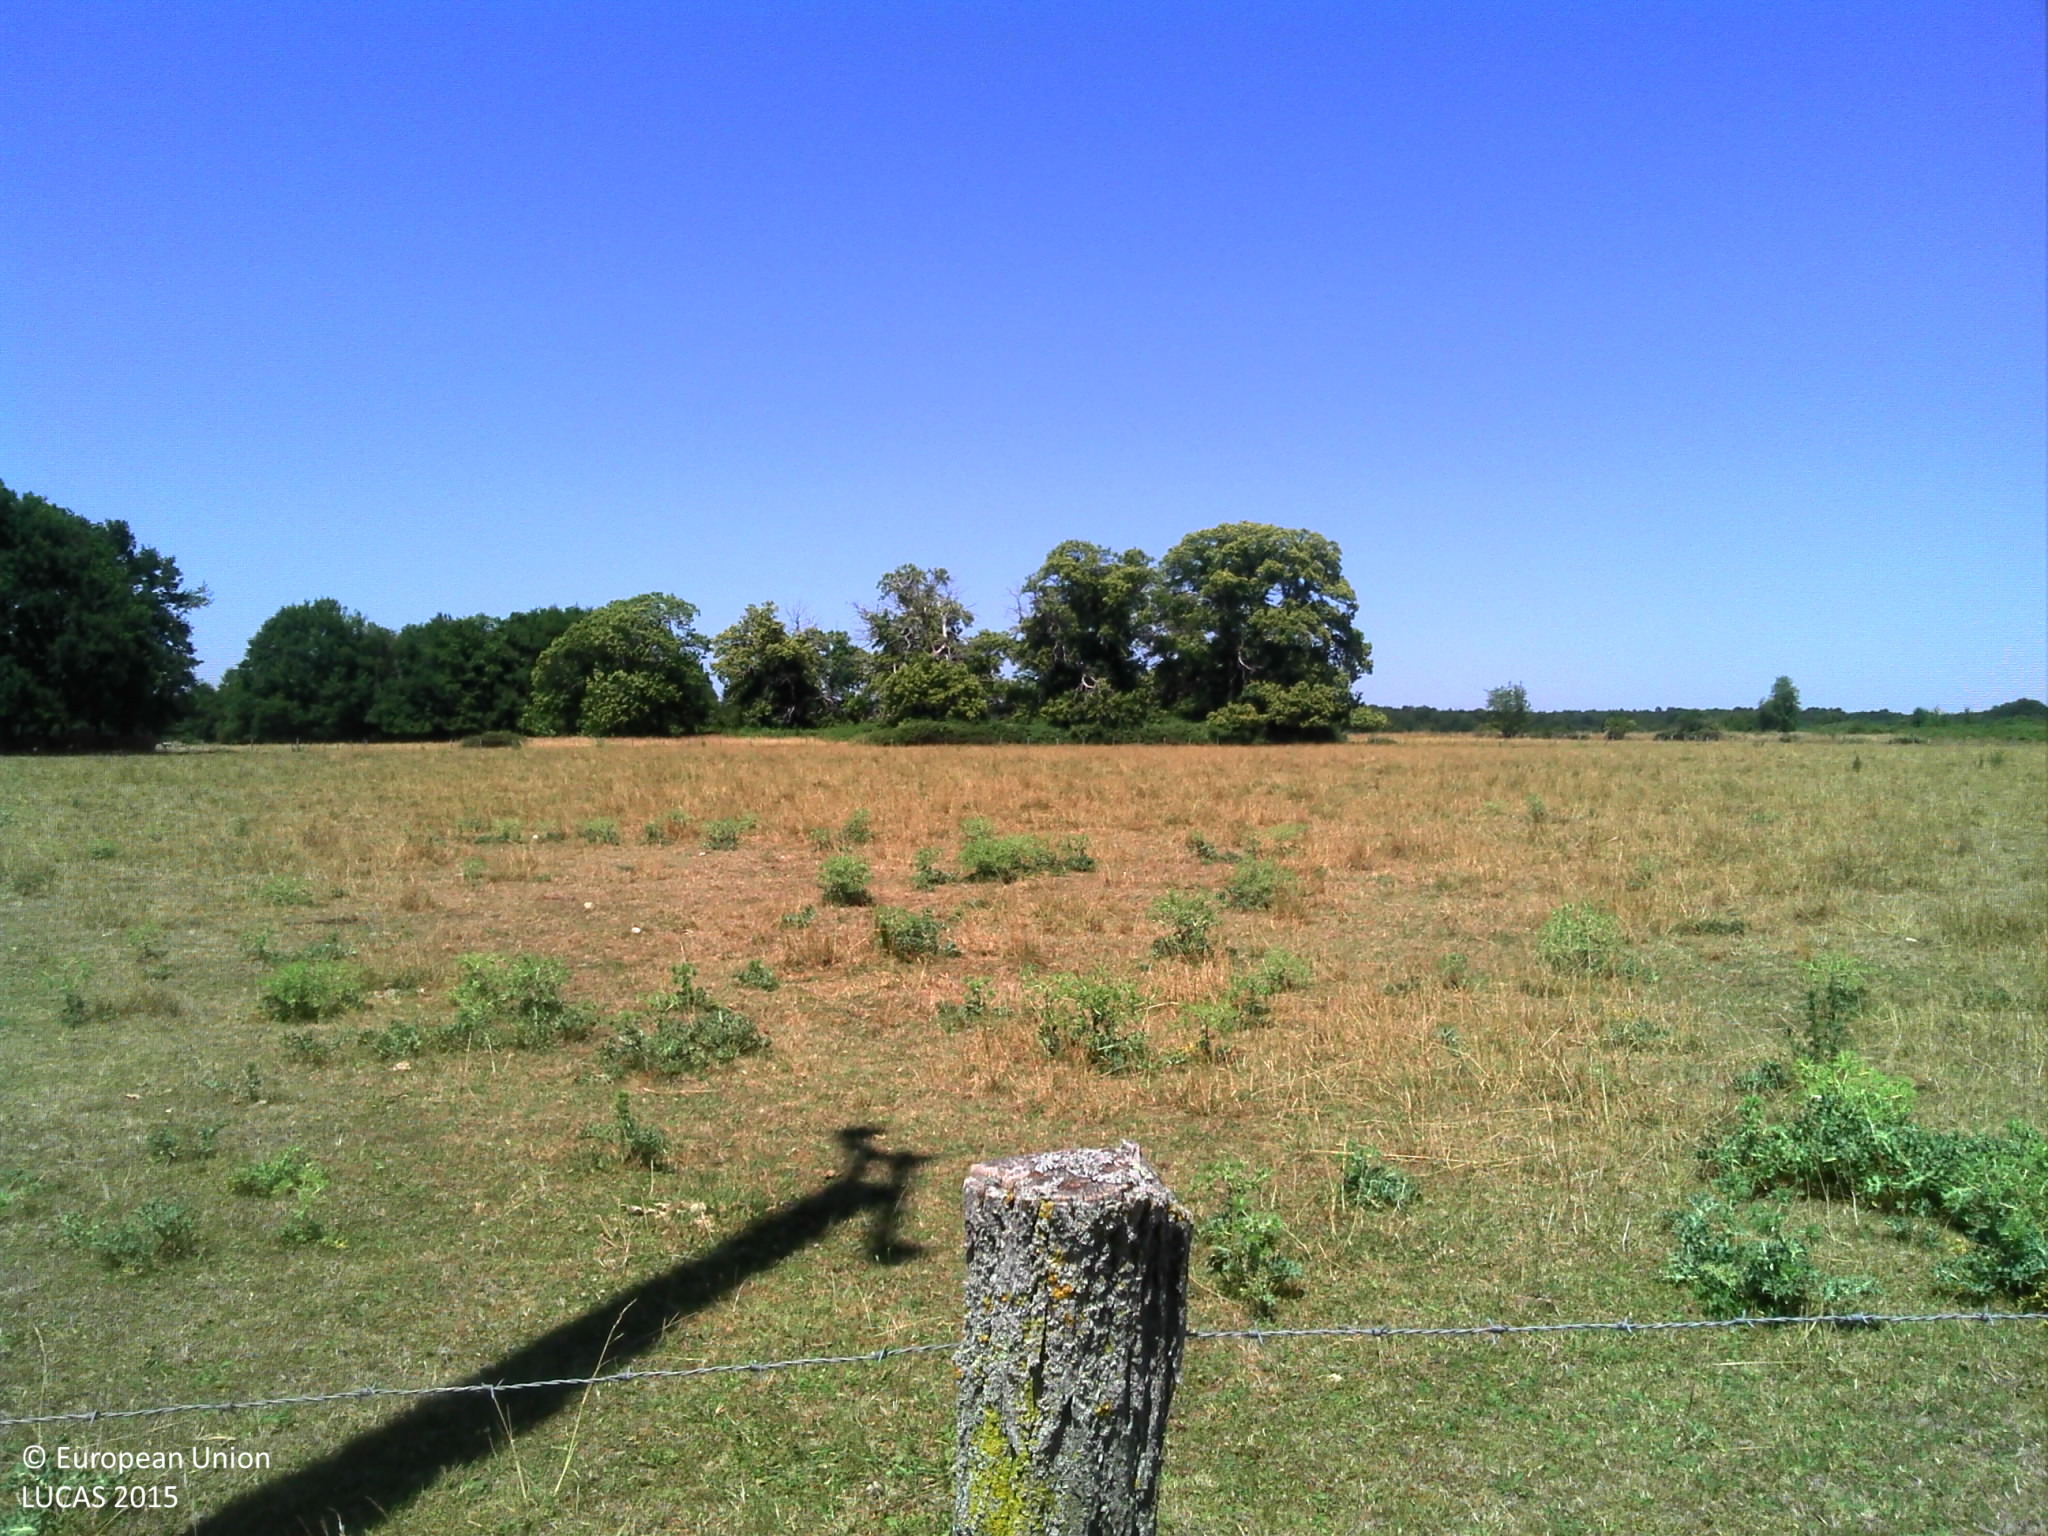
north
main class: Grassland
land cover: Grassland without tree/shrub cover
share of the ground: > 75 %
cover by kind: herbaceous plants 100 %
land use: Agriculture (excluding fallow land and kitchen gardens)
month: June
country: FR
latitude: 47.3869
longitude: 0.4006
